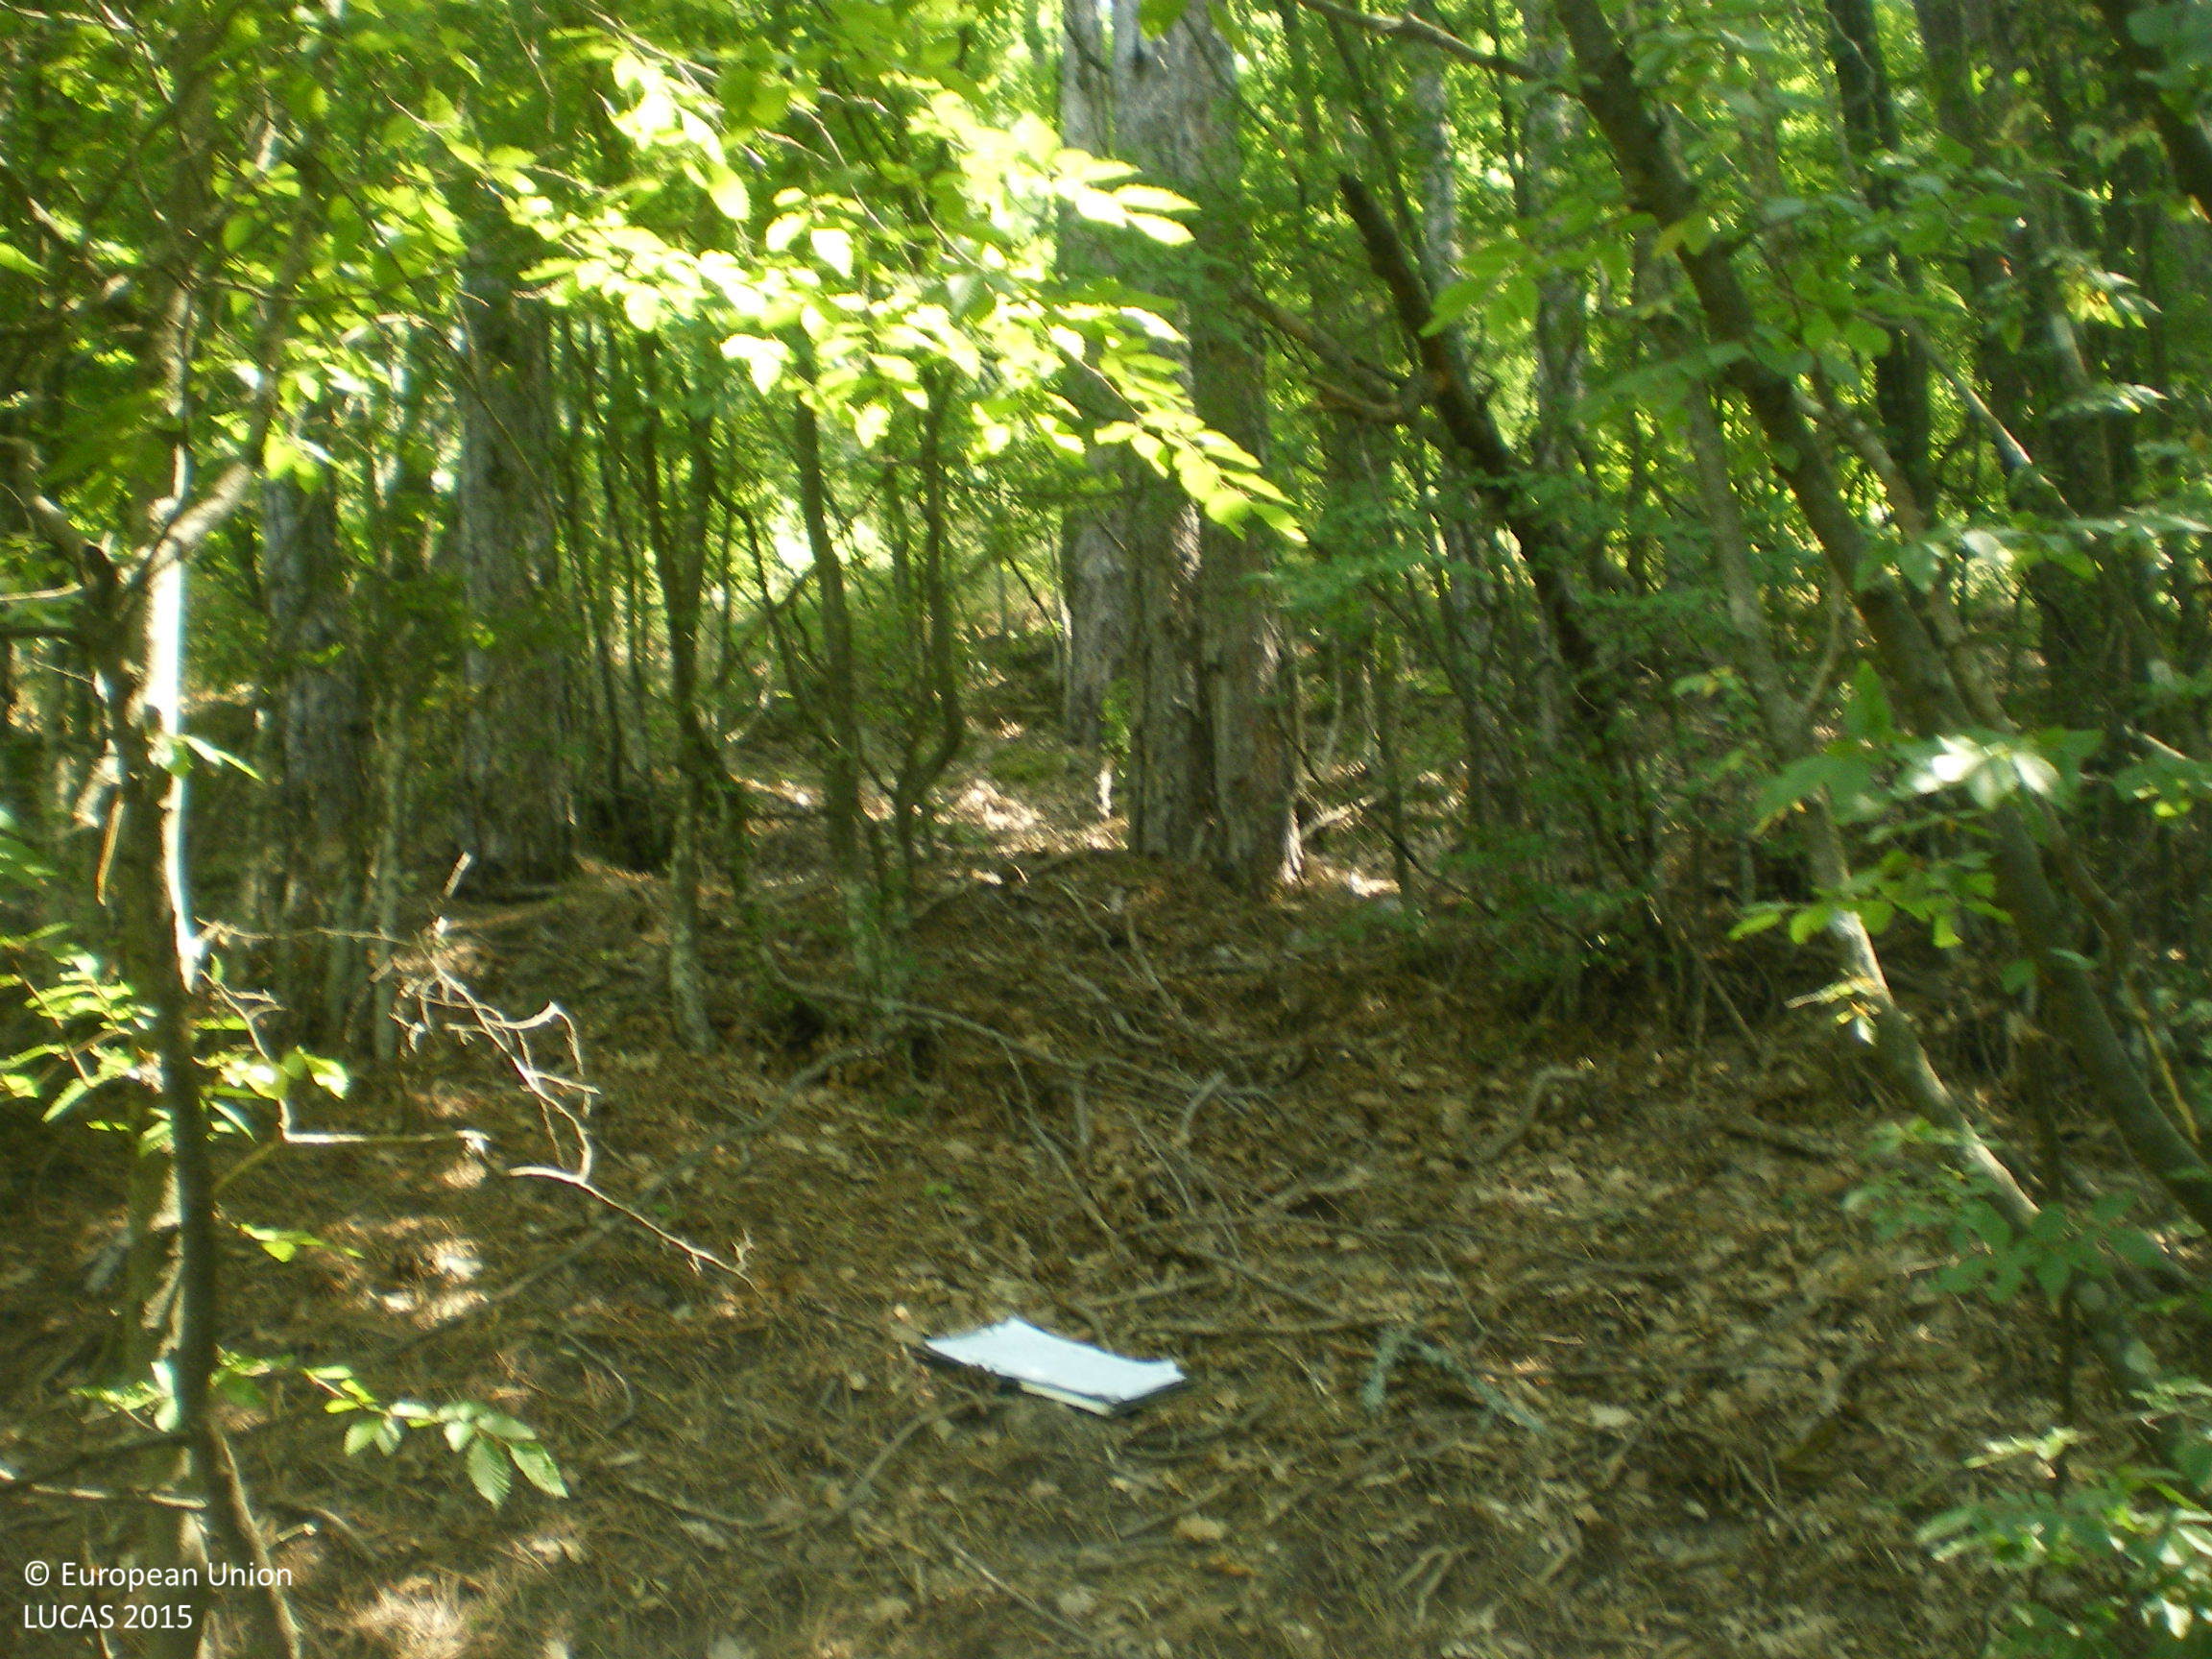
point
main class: Woodland
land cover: Pine dominated coniferous woodland
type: coniferous forest of the mediterranean region
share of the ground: > 75 %
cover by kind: coniferous forest trees 75 %, broadleaved forest trees 25 %
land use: Forestry
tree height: > 5 m
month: July
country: BG
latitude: 42.6757
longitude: 25.0606
